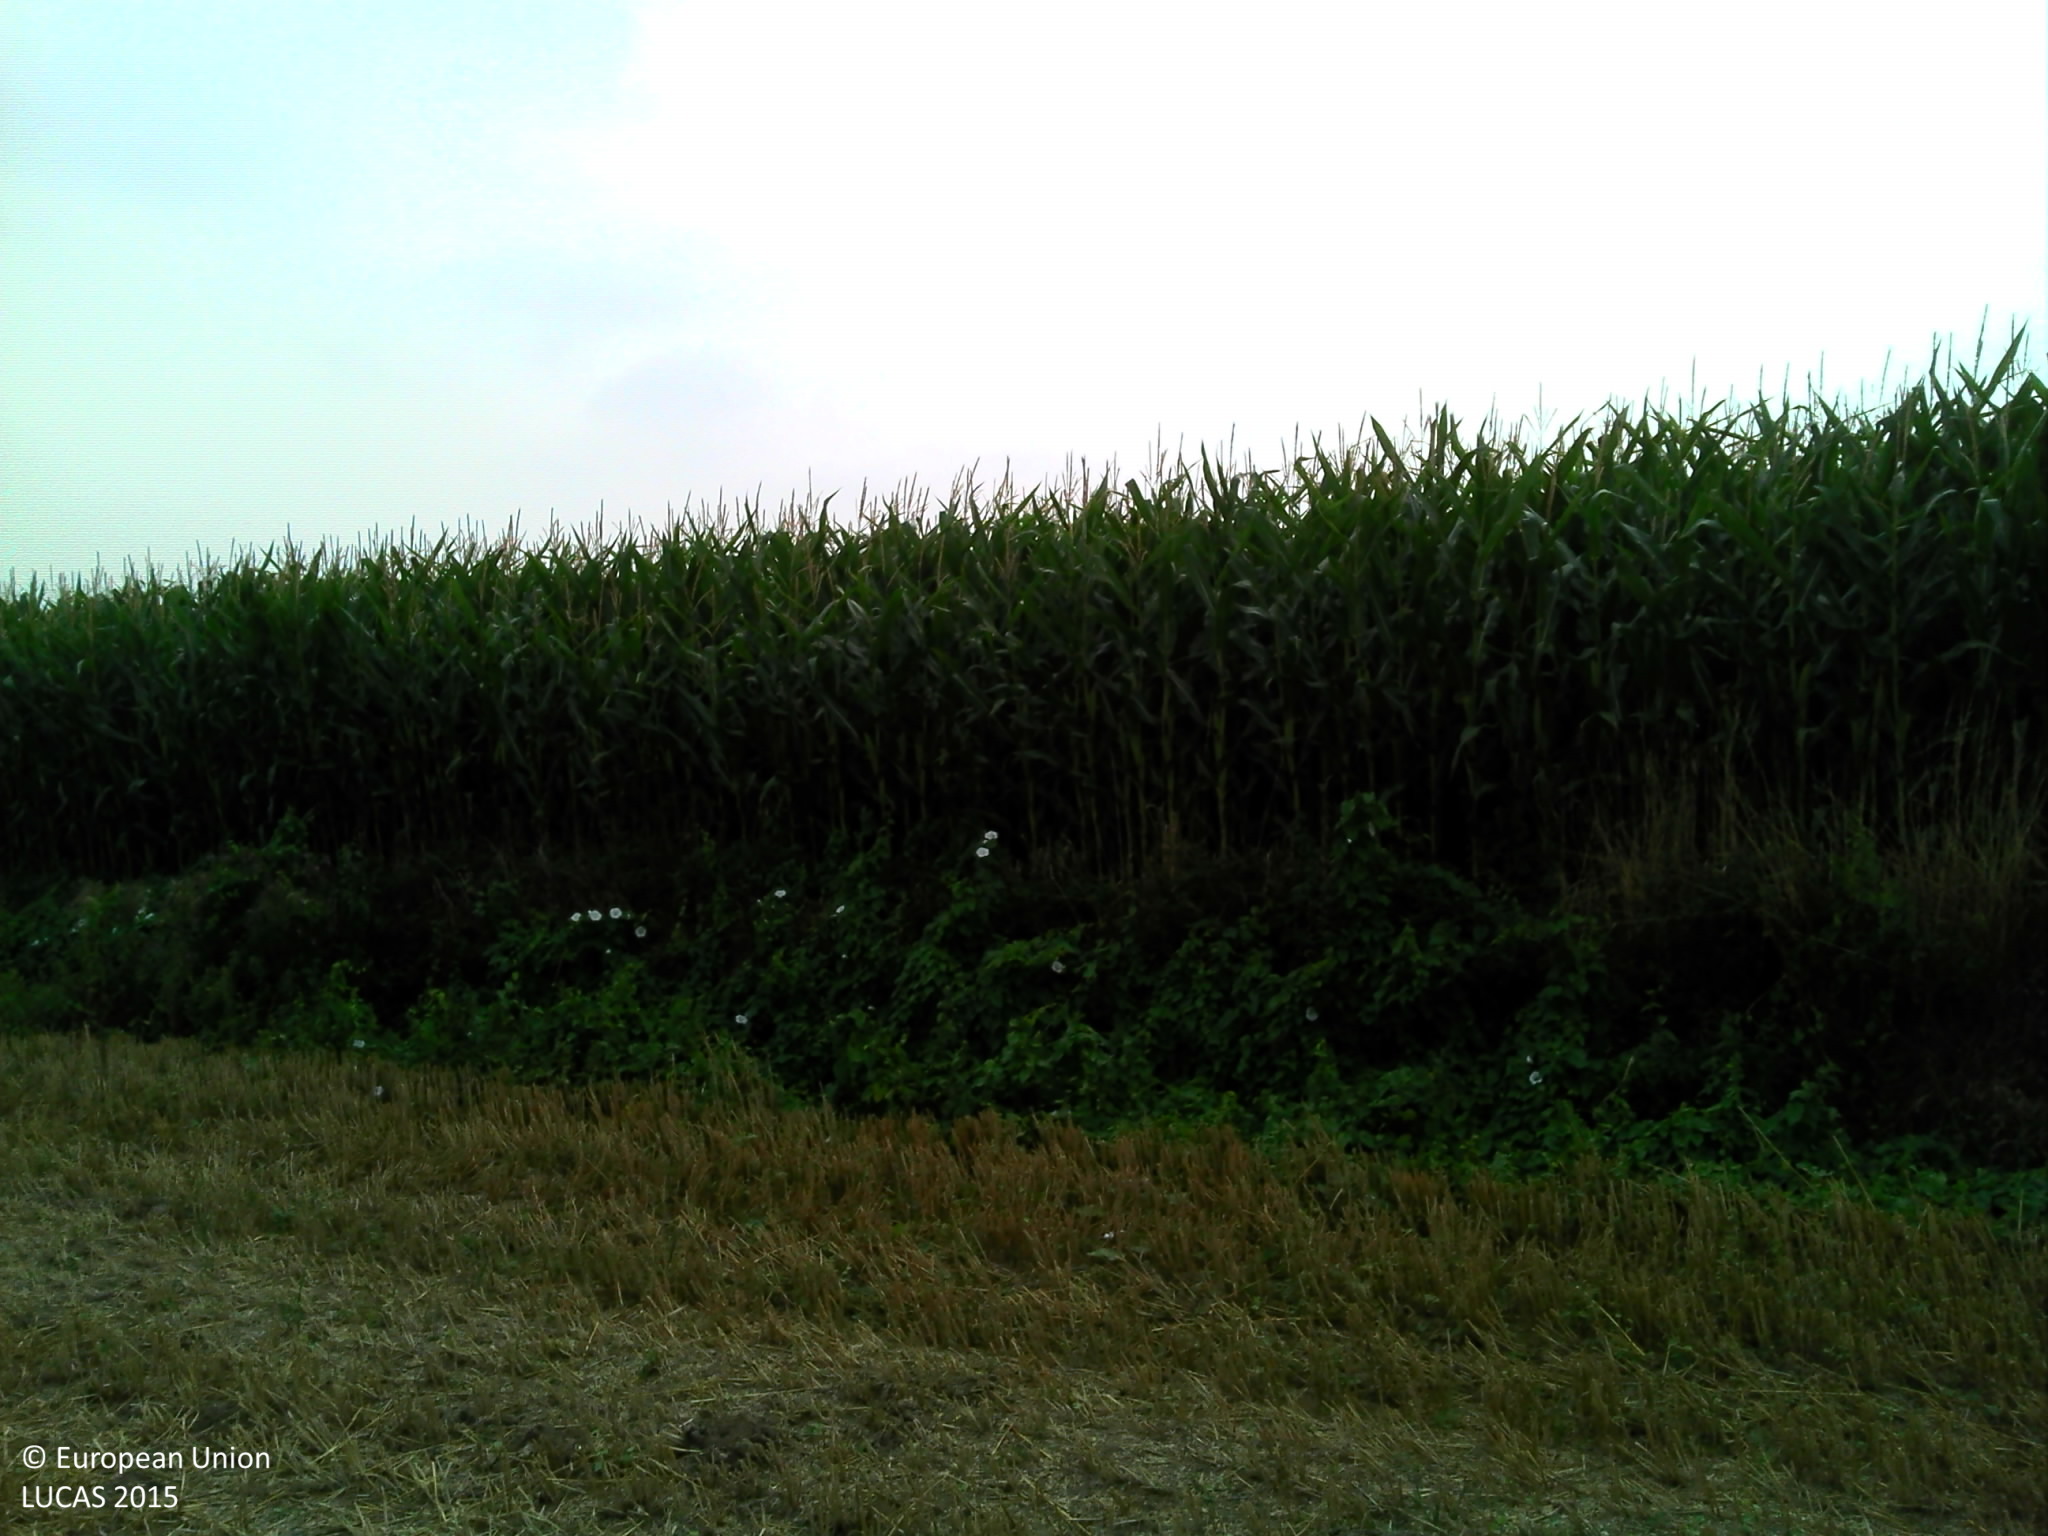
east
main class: Cropland
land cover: Common wheat
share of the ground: > 75 %
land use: Agriculture (excluding fallow land and kitchen gardens)
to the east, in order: Common wheat; Ditches and canals; Maize; Grass margins; Sugar beet
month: August
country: BE
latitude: 50.6645
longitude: 3.4700
